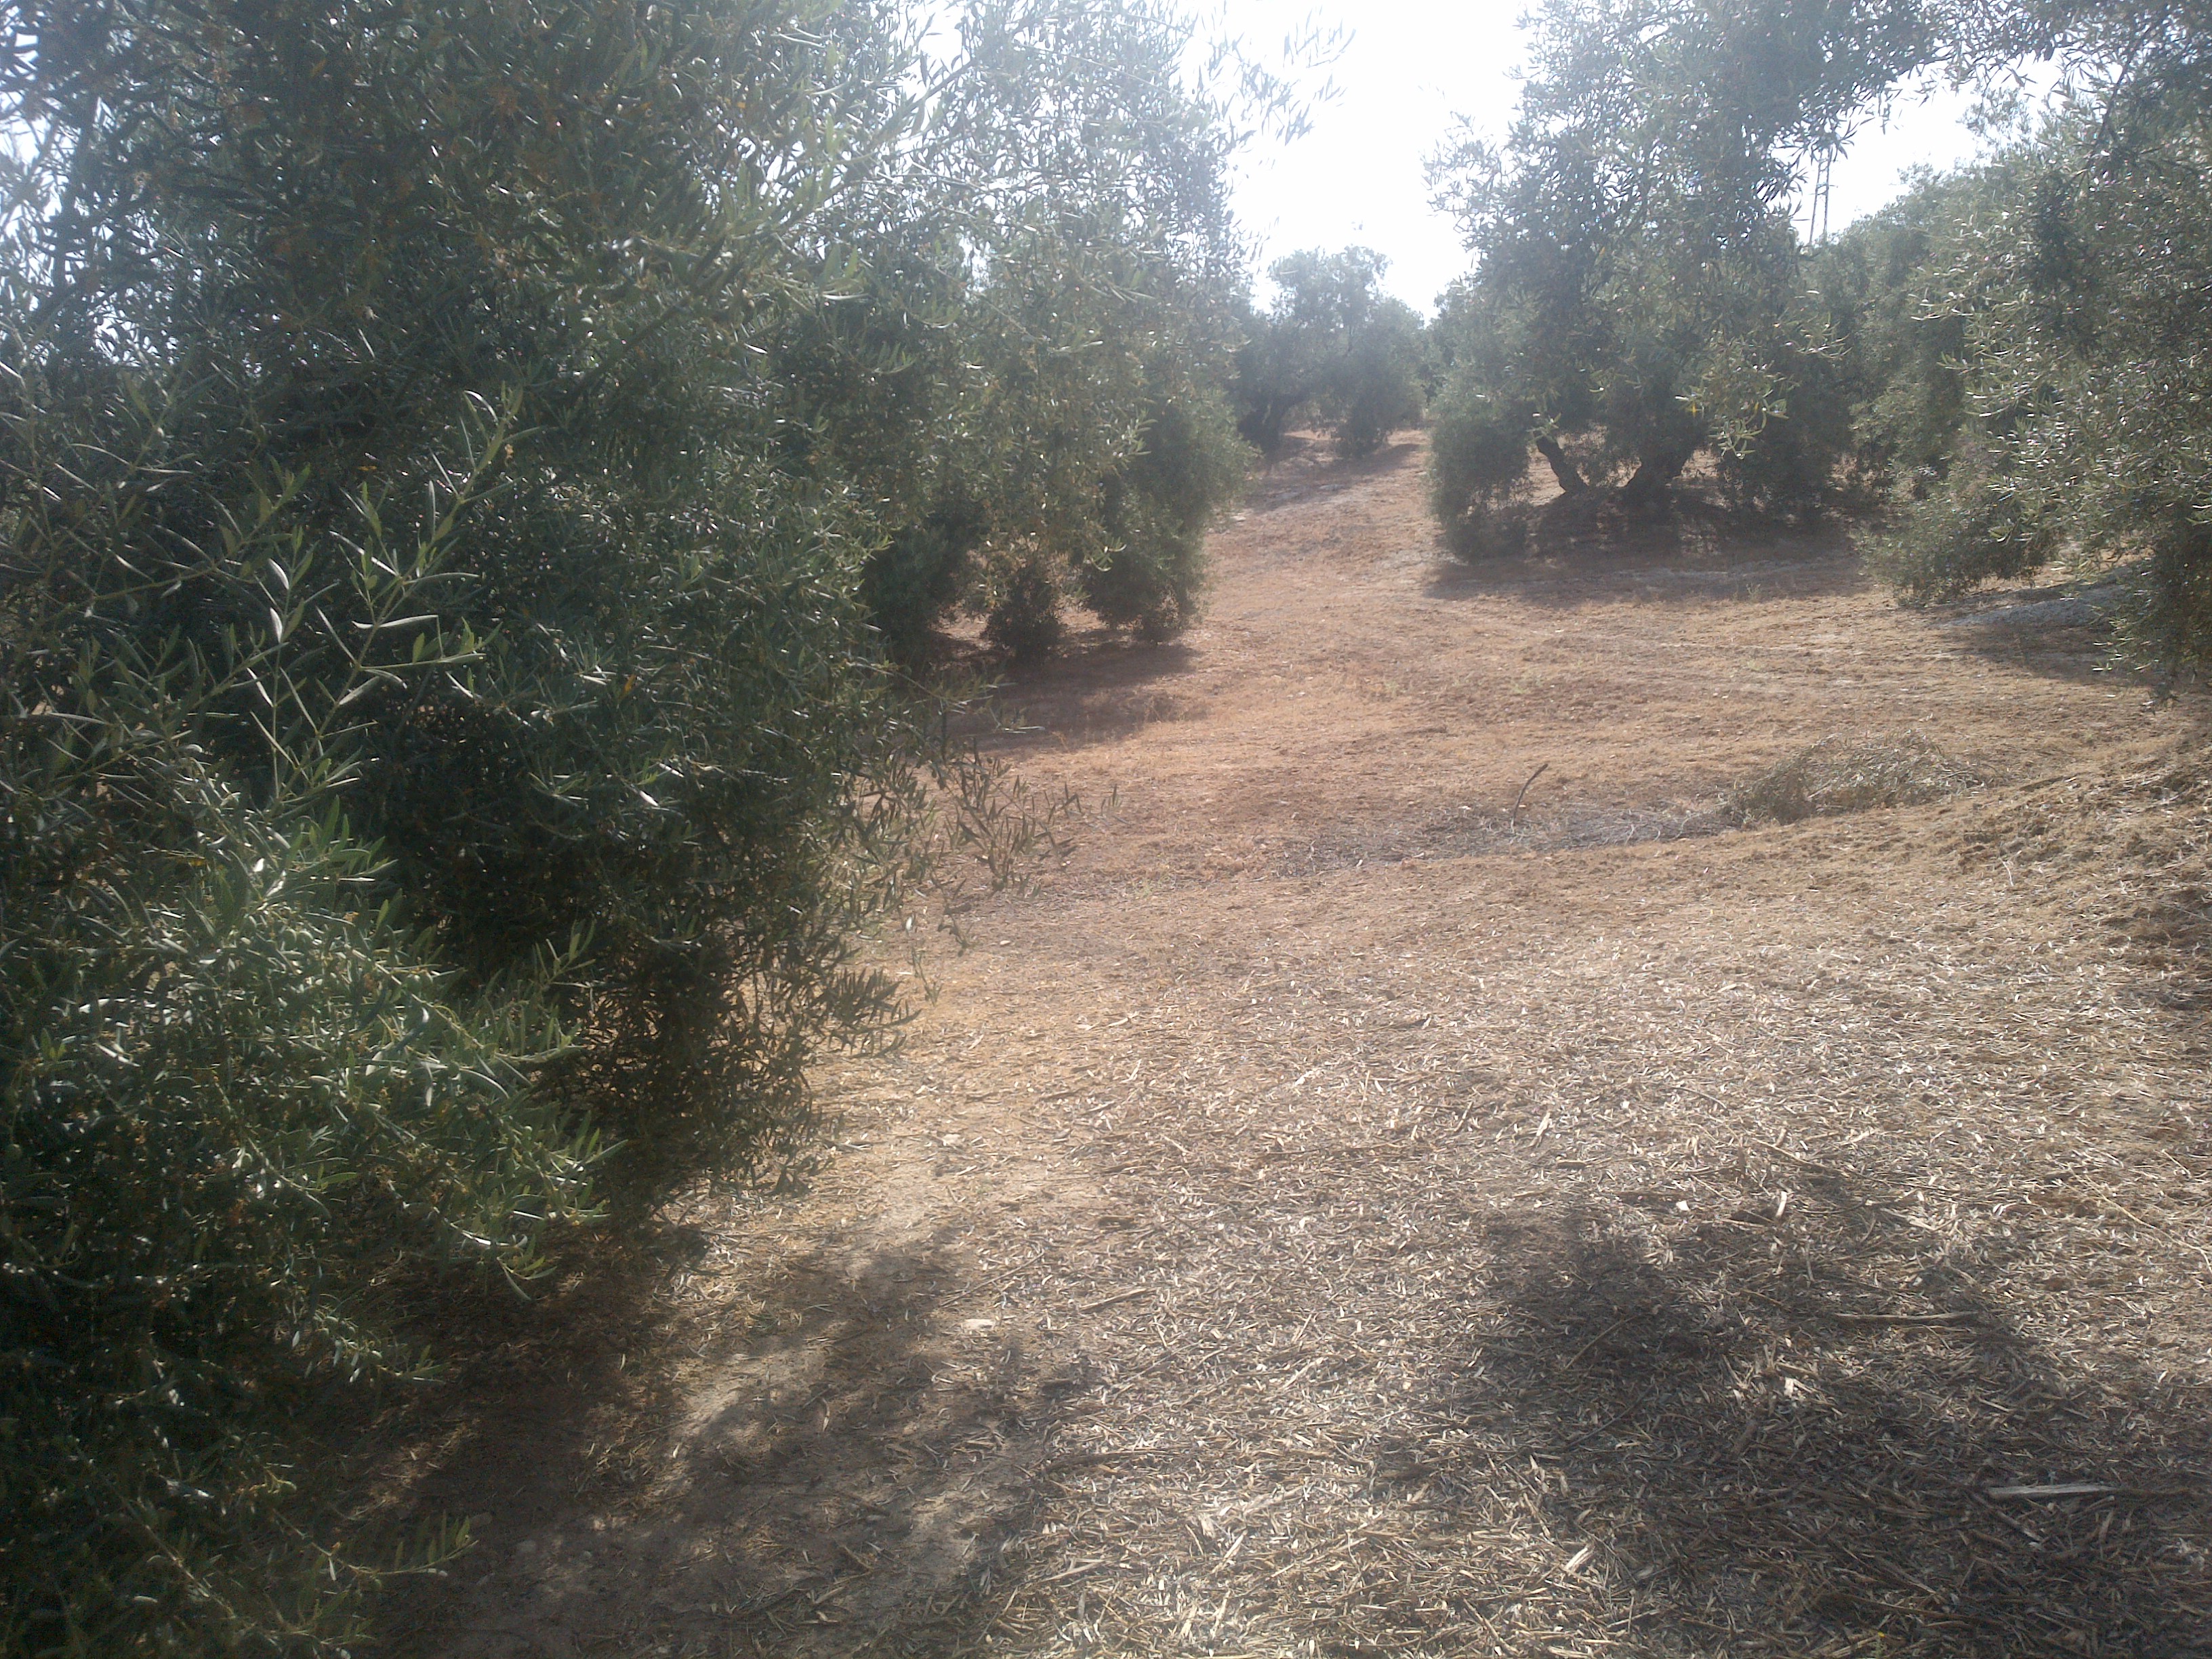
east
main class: Cropland
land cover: Olive groves
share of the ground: 50 - 75 %
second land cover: Other bare soil
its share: > 75 %
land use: Agriculture (excluding fallow land and kitchen gardens)
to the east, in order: Olive groves; Other bare soil; Electric lines; Olive groves; Electric lines; Olive groves
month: July
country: ES
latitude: 37.3883
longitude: -4.4706
